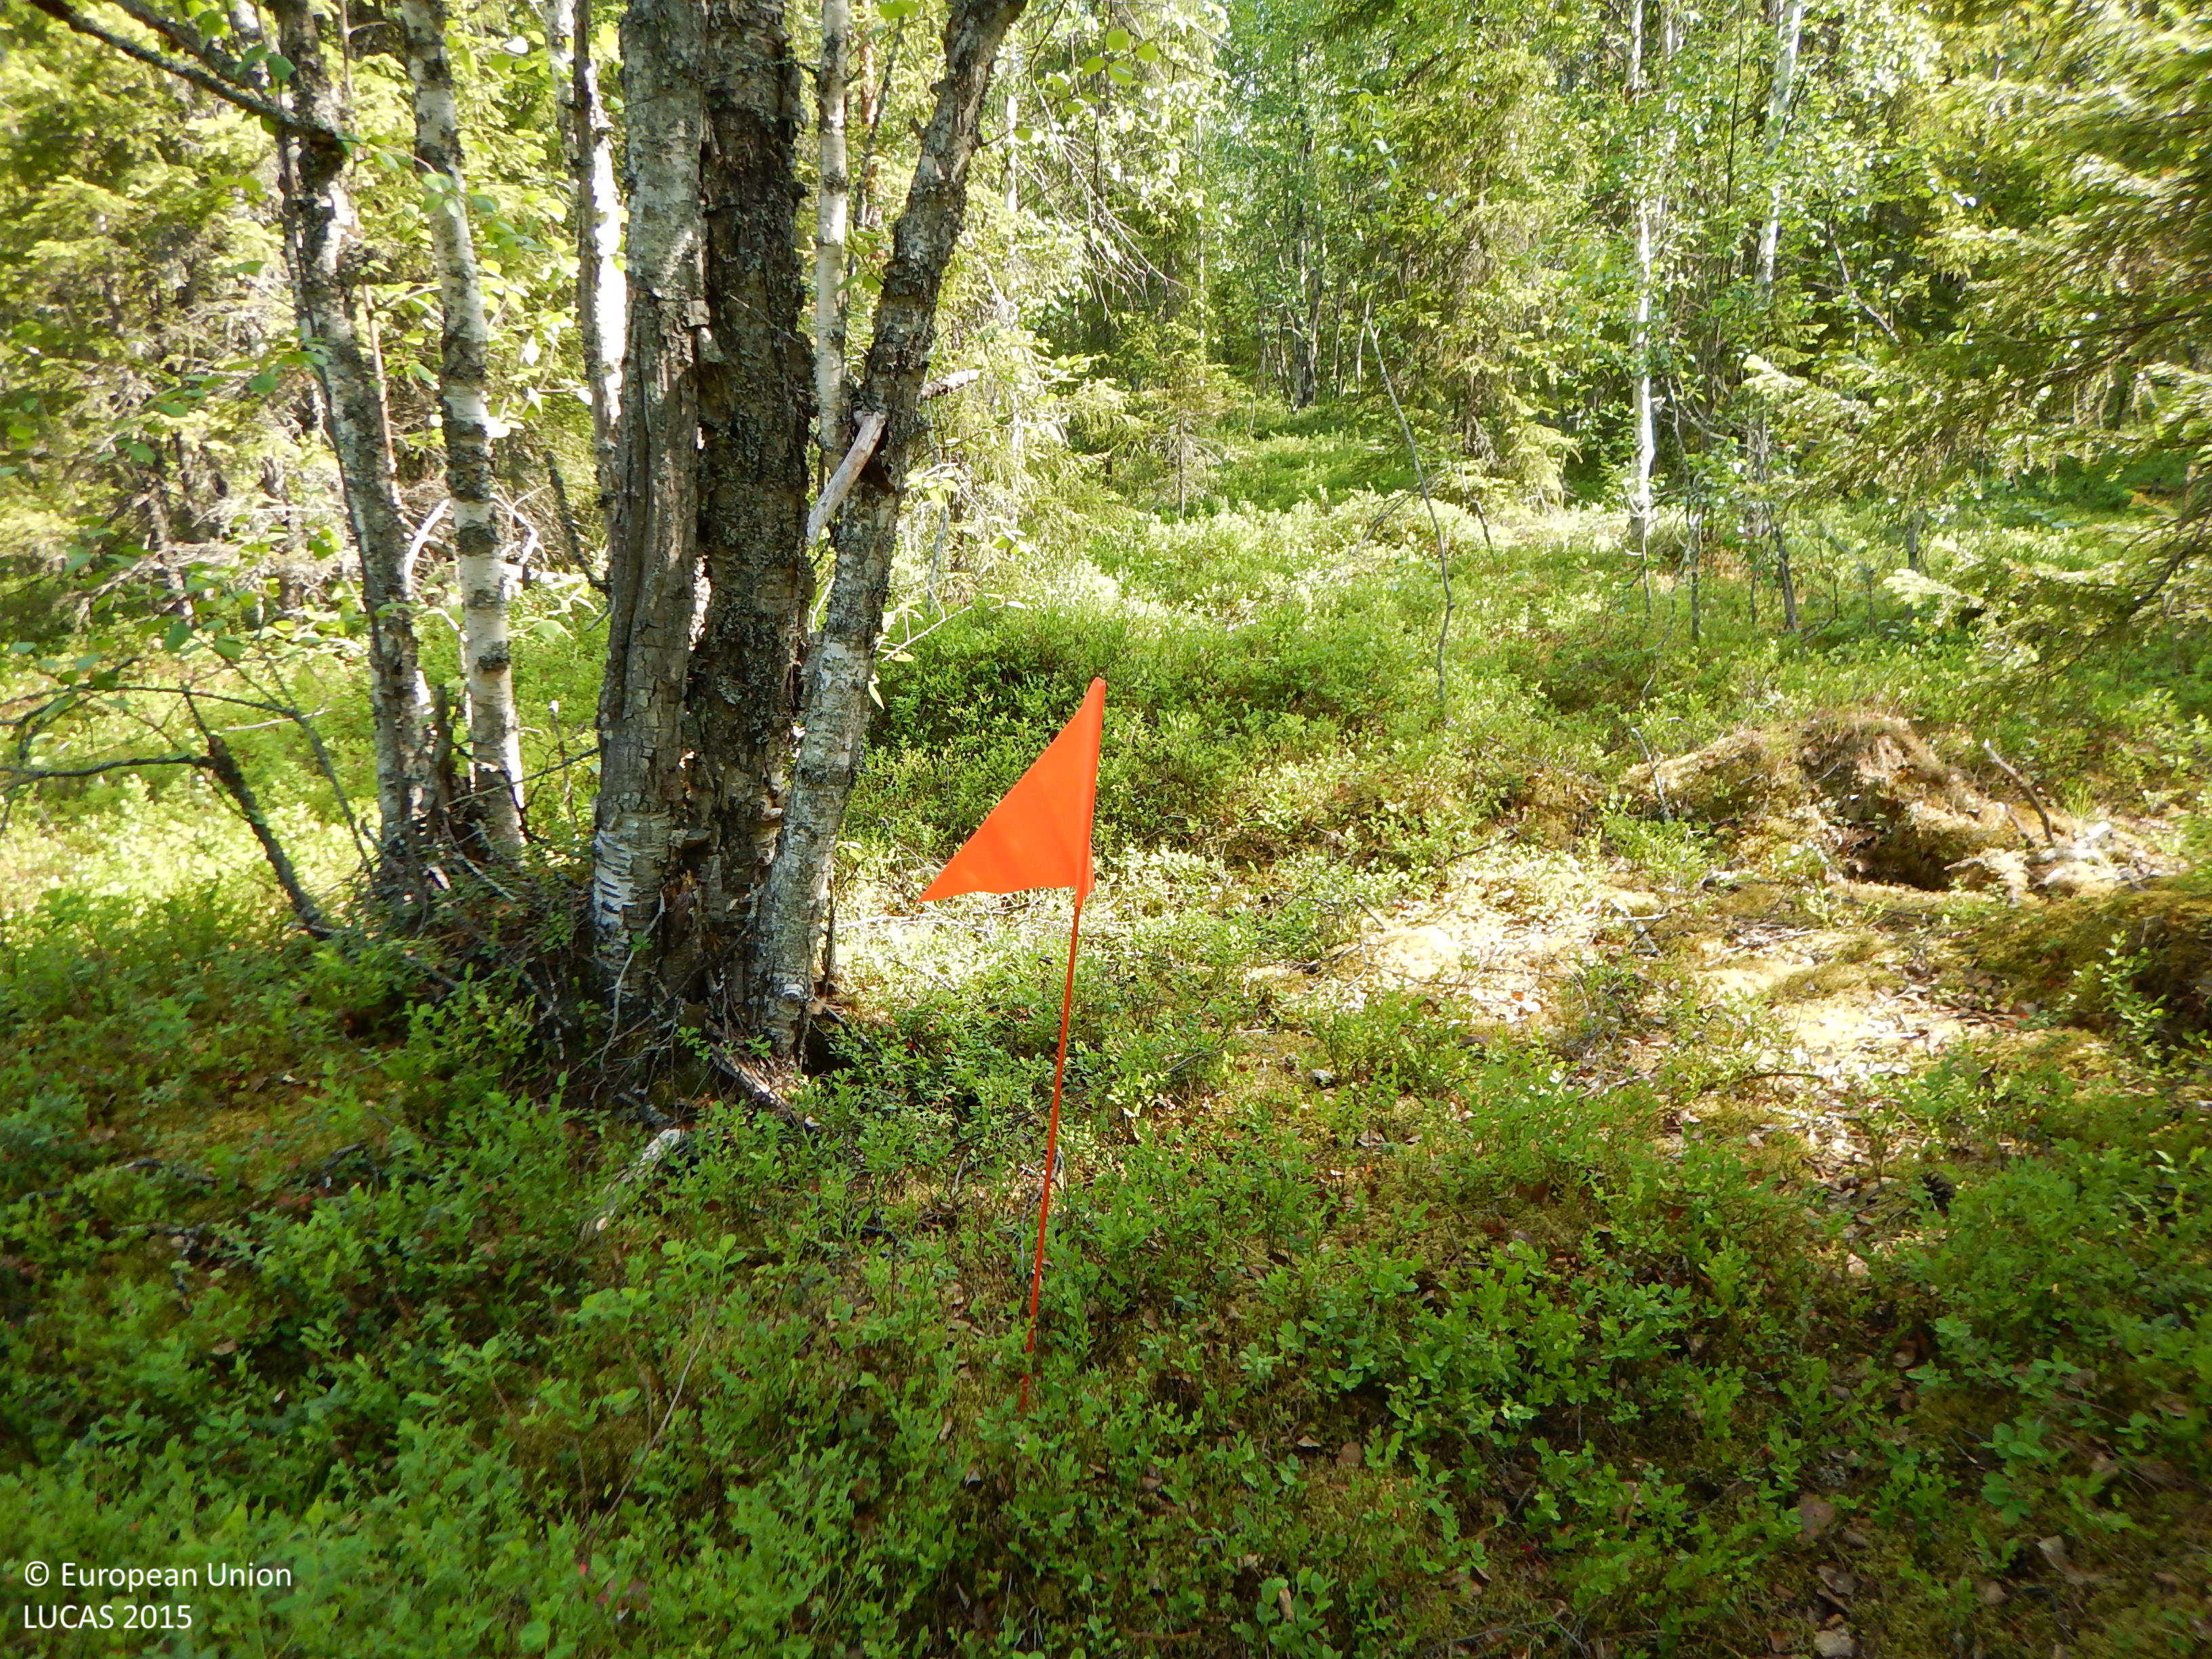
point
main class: Woodland
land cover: Spruce dominated mixed woodland
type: boreal forest
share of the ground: 25 - 50 %
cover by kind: shrubs 30 %, lichens and mosses 25 %, coniferous forest trees 20 %, broadleaved forest trees 15 %, herbaceous plants 10 %
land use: Forestry
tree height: > 5 m
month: July
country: SE
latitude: 65.0954
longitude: 18.5404
